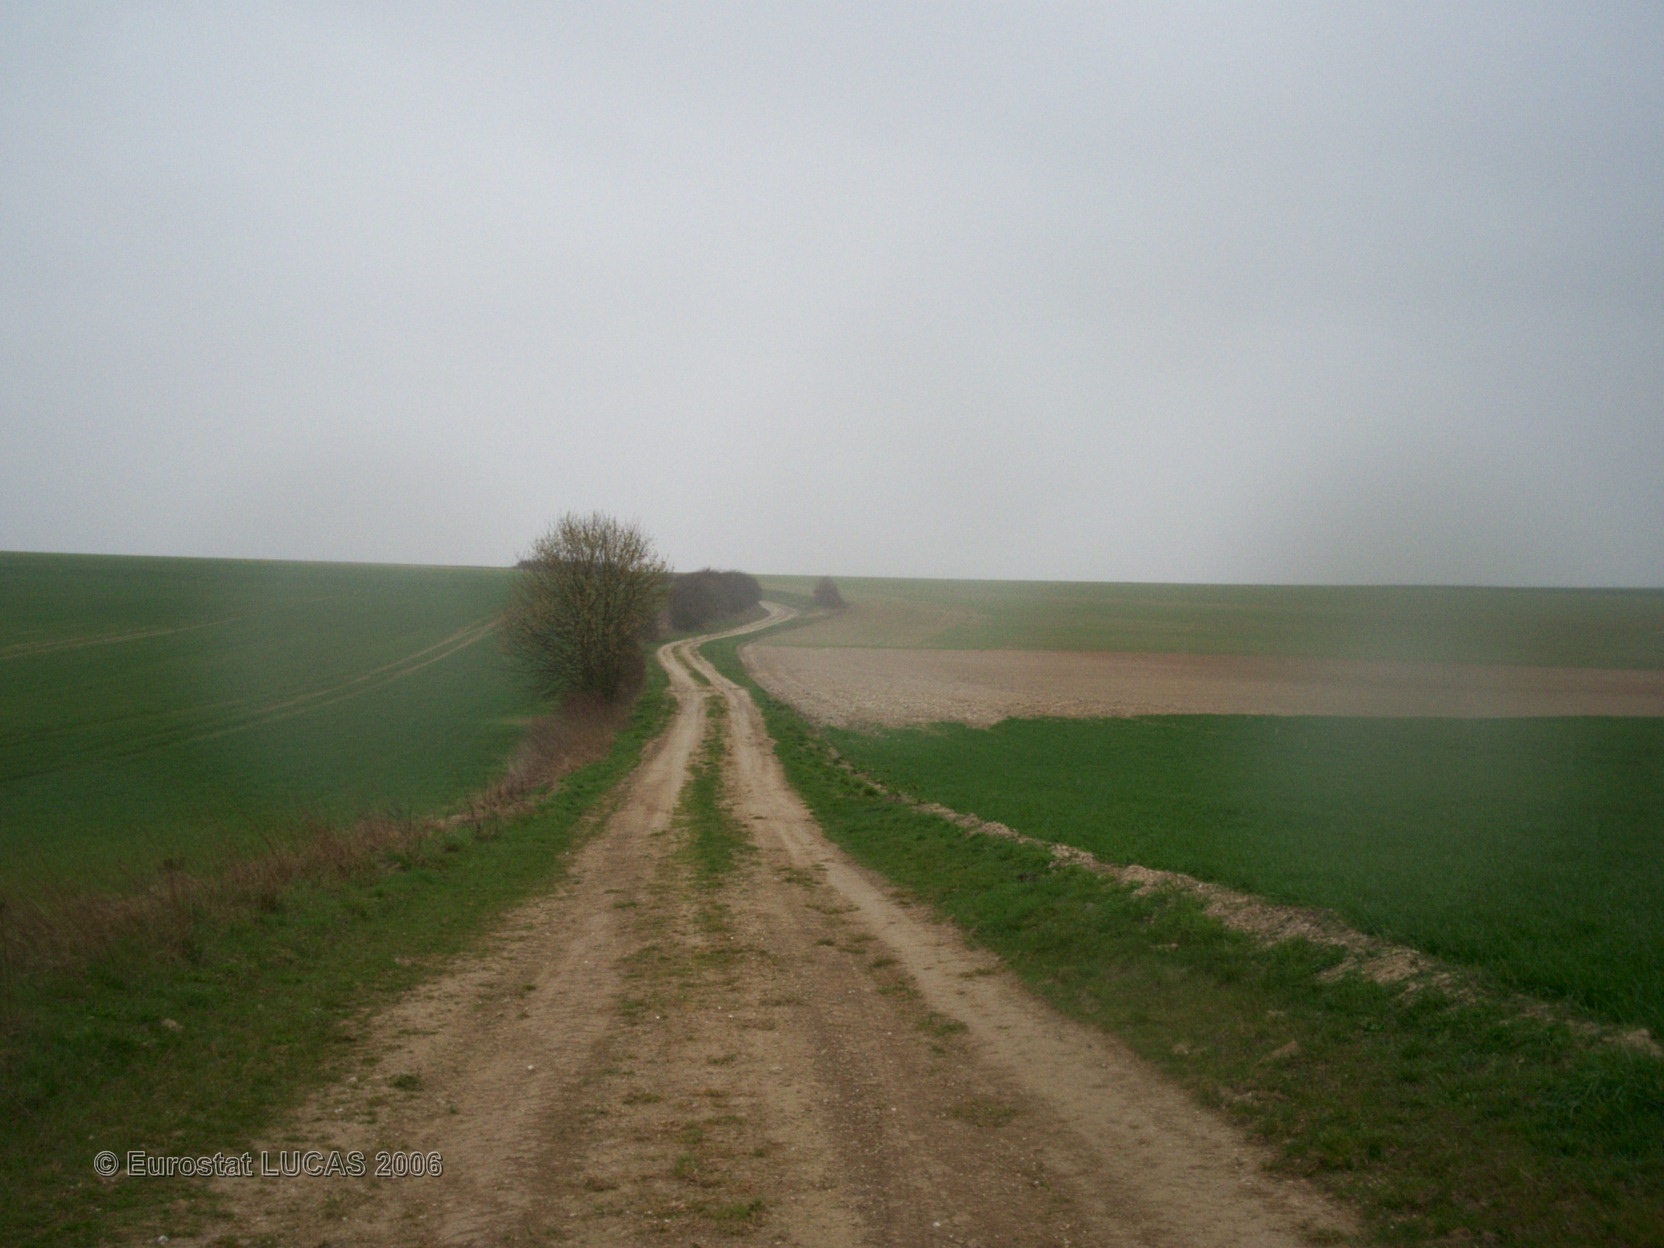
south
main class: Cropland
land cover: Common wheat
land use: Agriculture (excluding fallow land and kitchen gardens)
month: April
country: FR
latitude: 49.2564
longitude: 4.4592
